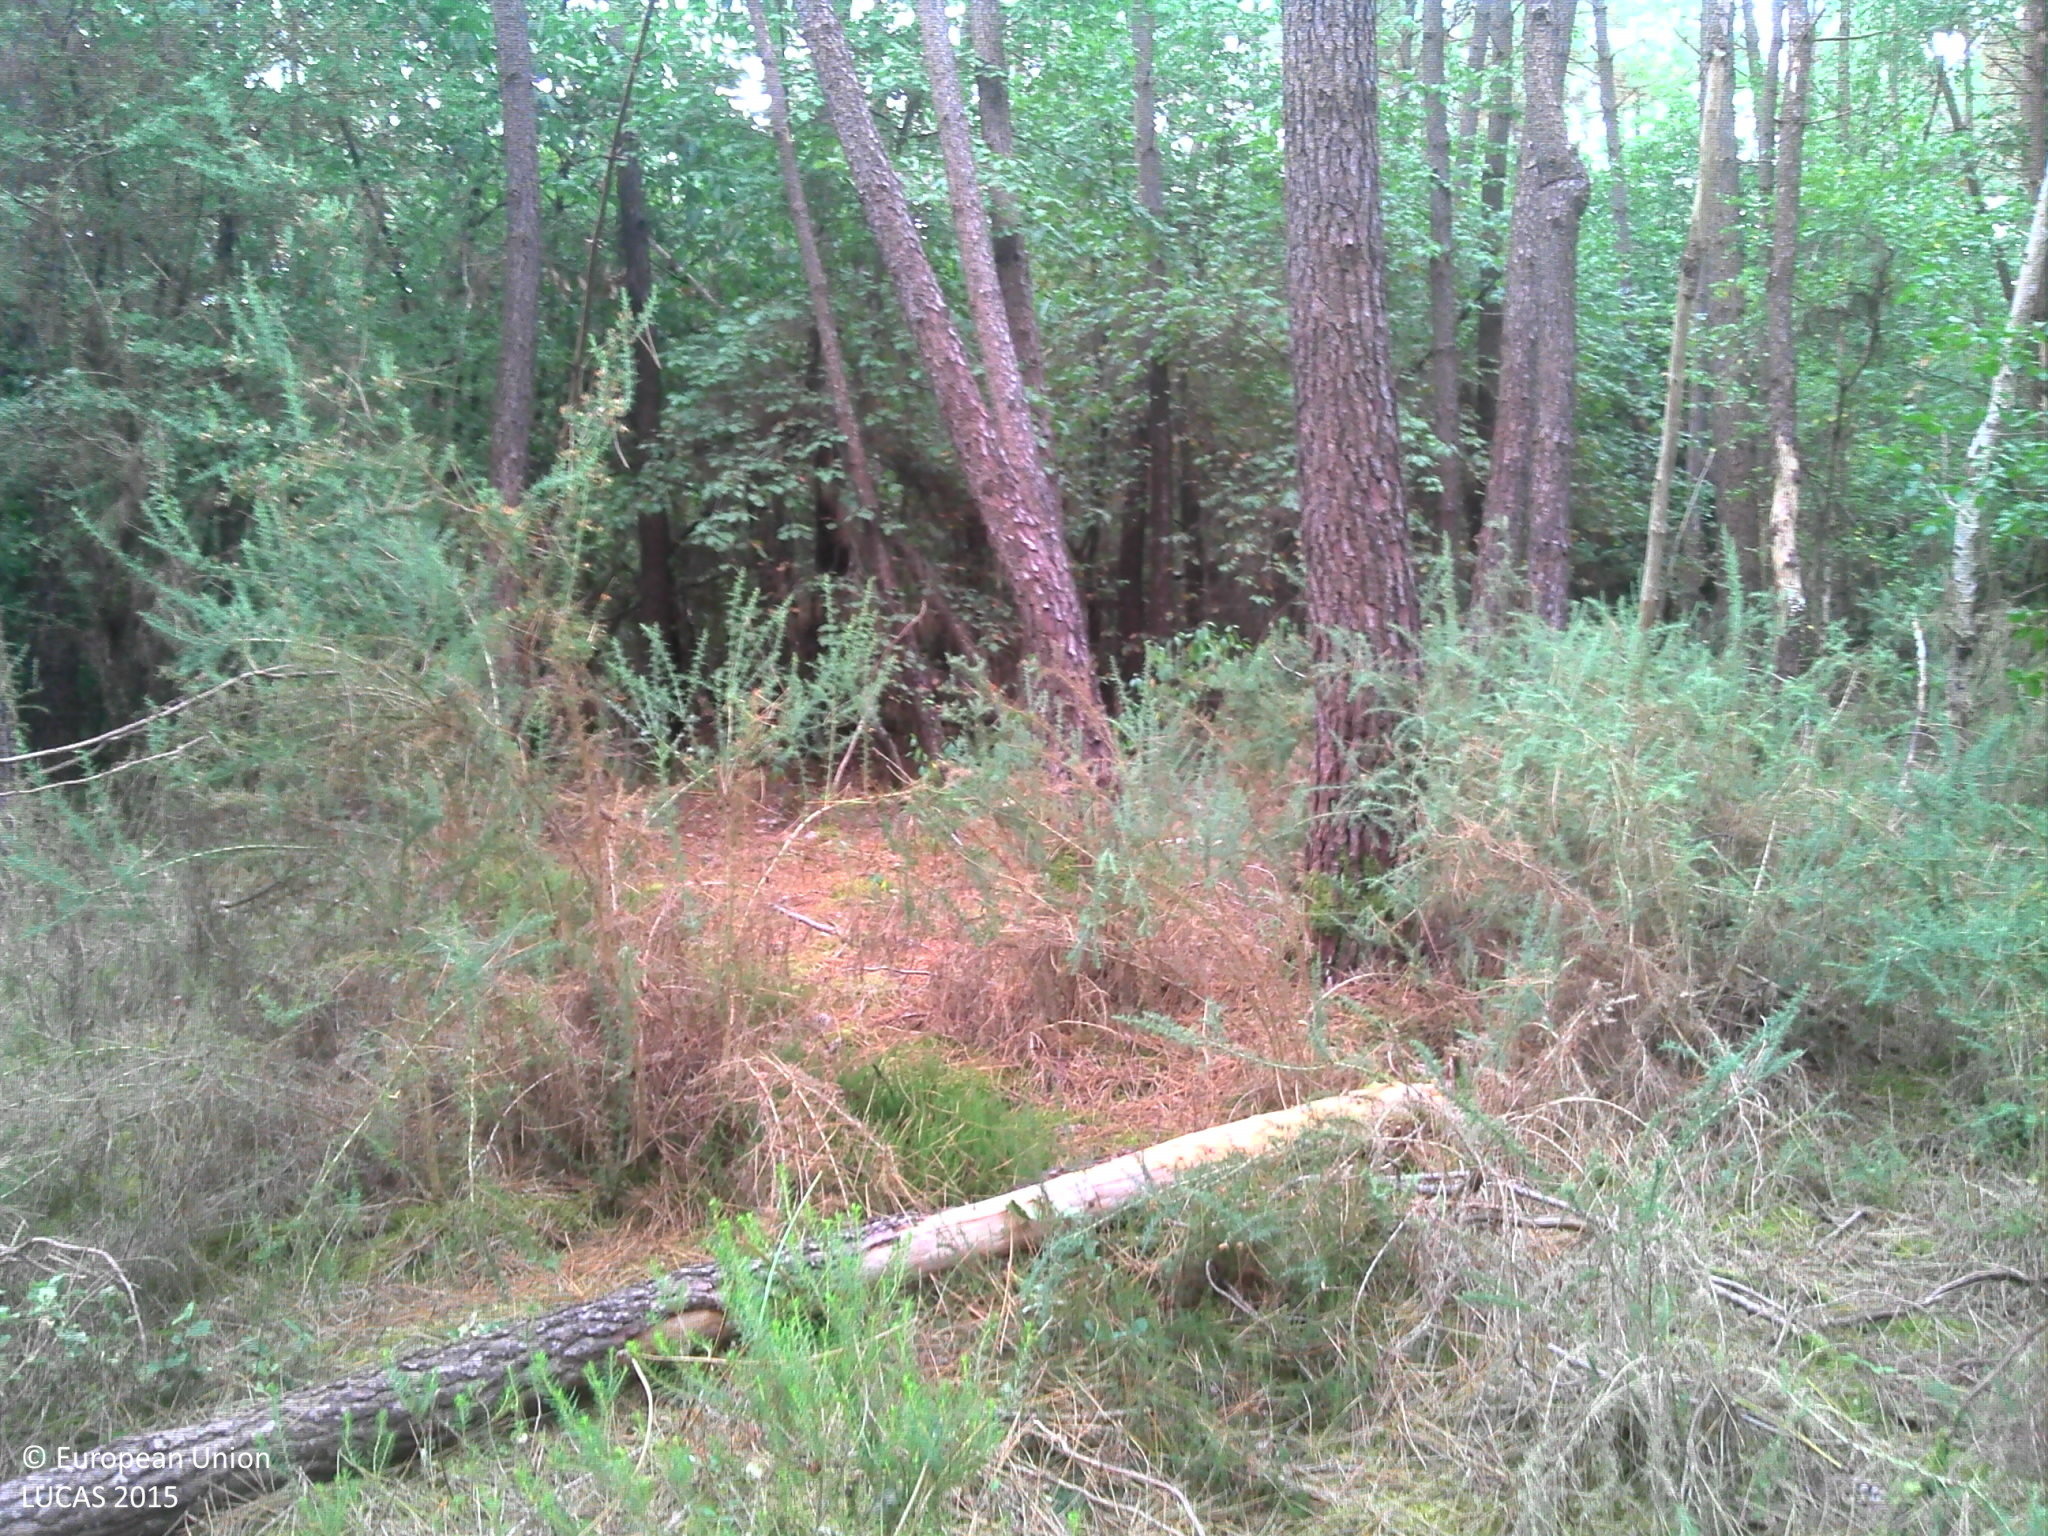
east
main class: Woodland
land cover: Pine dominated mixed woodland
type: hemiboreal forest and nemoral coniferous forest and mixed broadleaved-coniferous forest
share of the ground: > 75 %
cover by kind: coniferous forest trees 50 %, broadleaved forest trees 20 %, shrubs 15 %, herbaceous plants 10 %, lichens and mosses 5 %
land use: Forestry
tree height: > 5 m
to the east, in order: Pine dominated mixed woodland
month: July
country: FR
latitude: 46.9900
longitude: 0.4208
